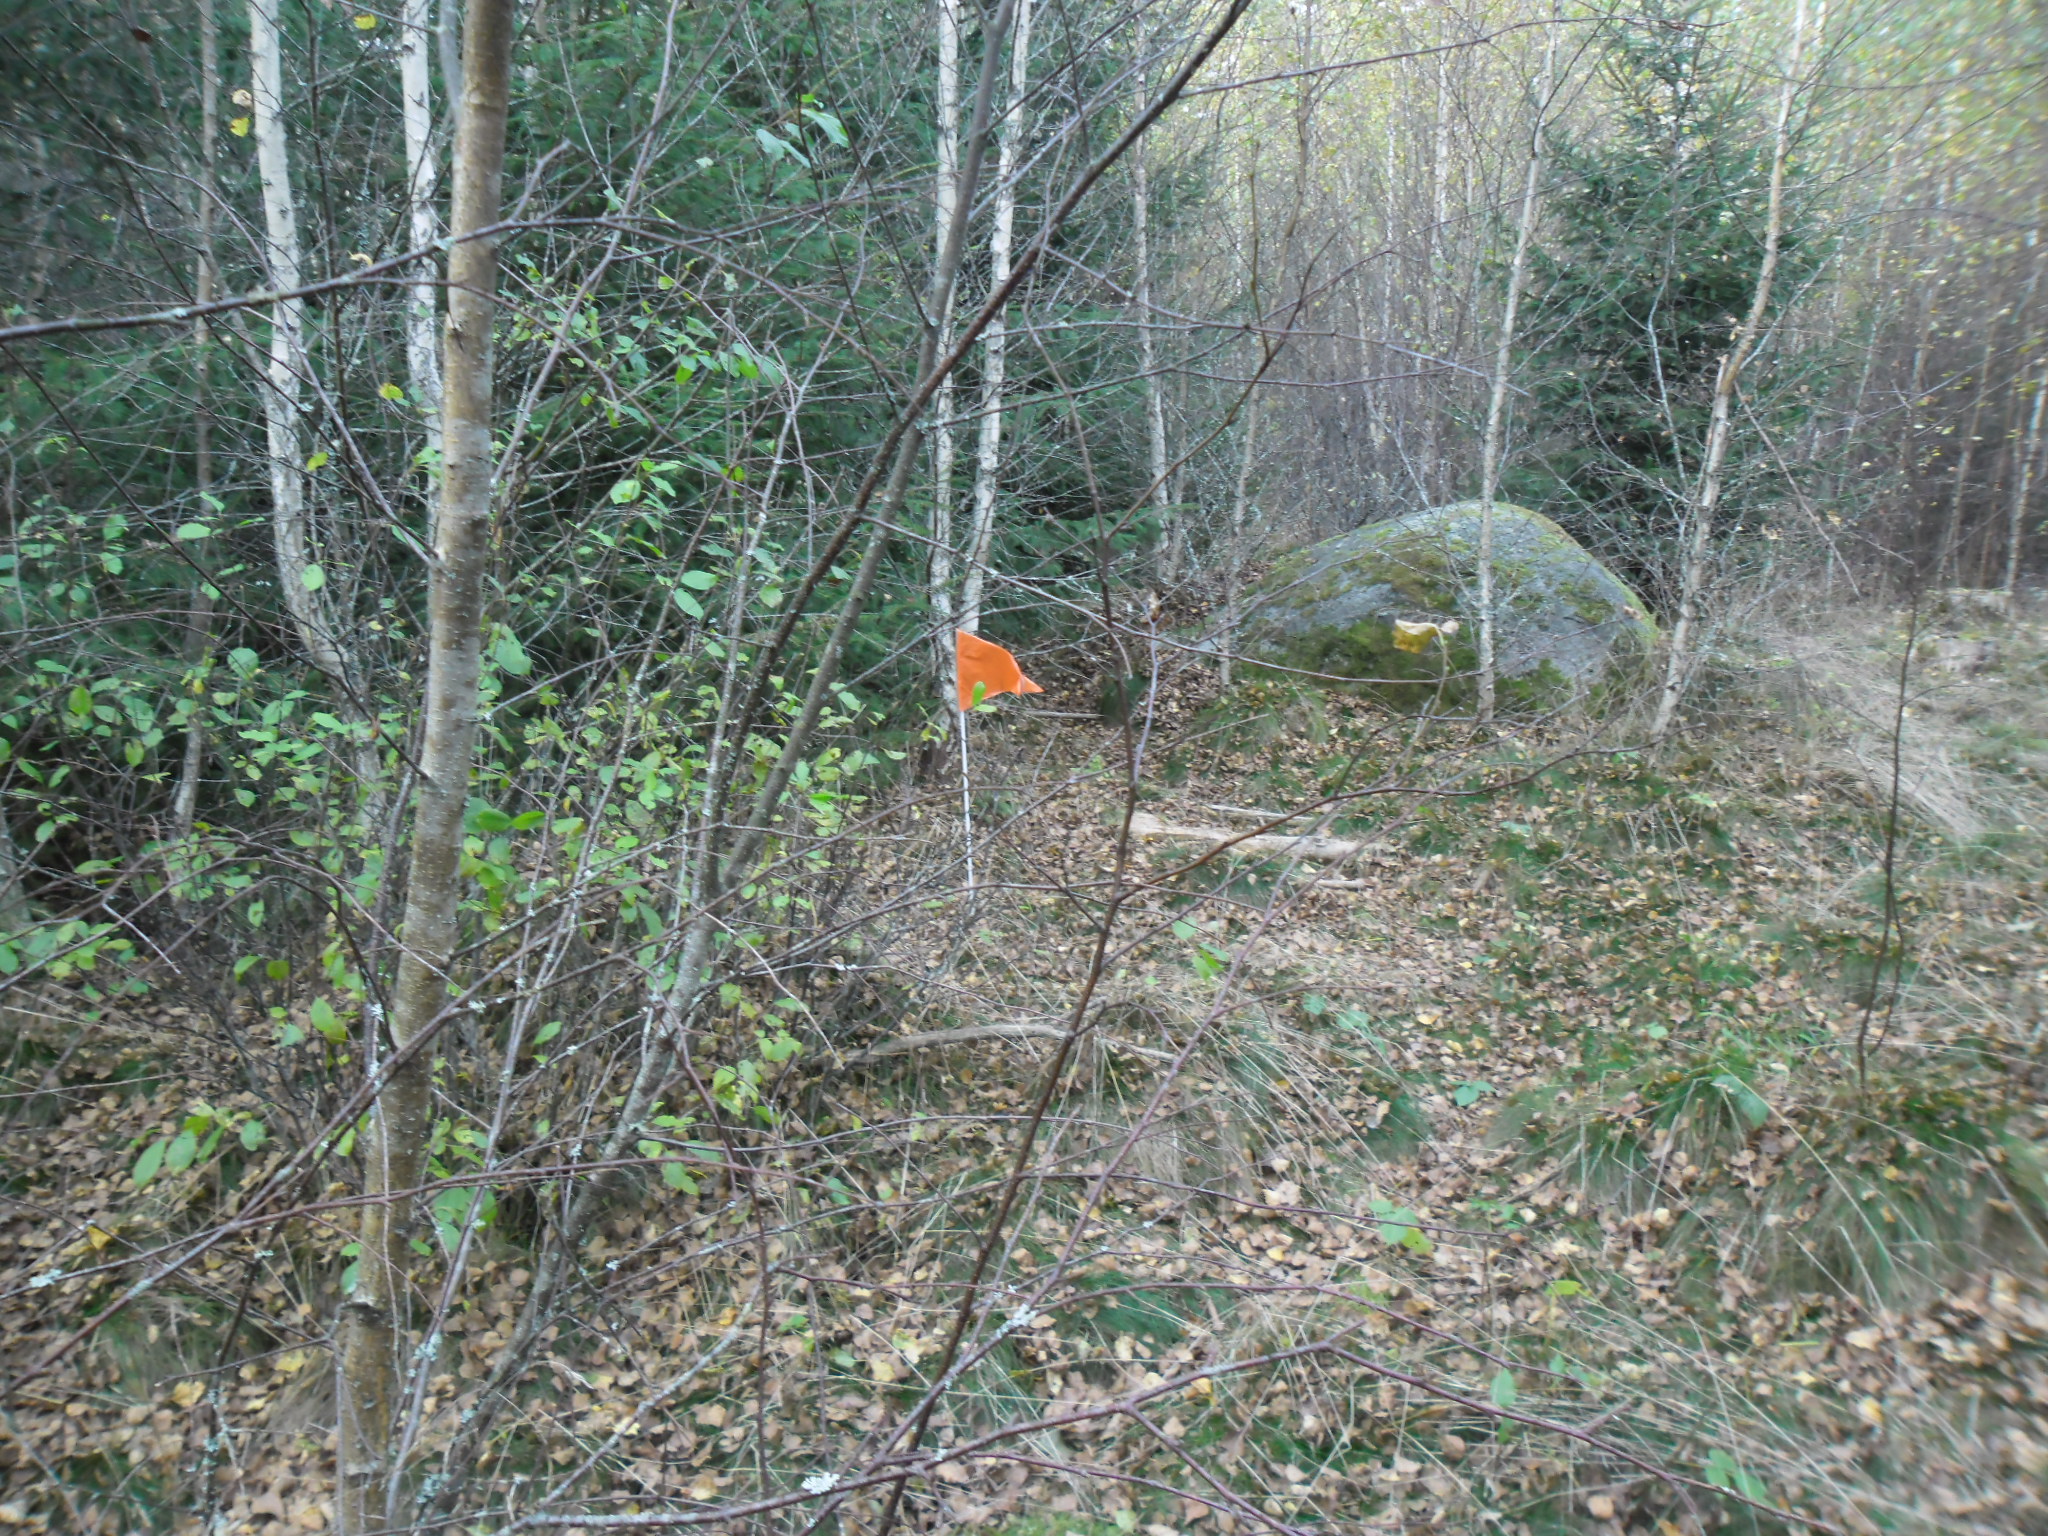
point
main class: Woodland
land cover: Spruce dominated mixed woodland
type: boreal forest
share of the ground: > 75 %
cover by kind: coniferous forest trees 60 %, broadleaved forest trees 30 %, herbaceous plants 10 %
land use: Forestry
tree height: < 5 m
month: October
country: SE
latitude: 56.2947
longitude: 13.7621
